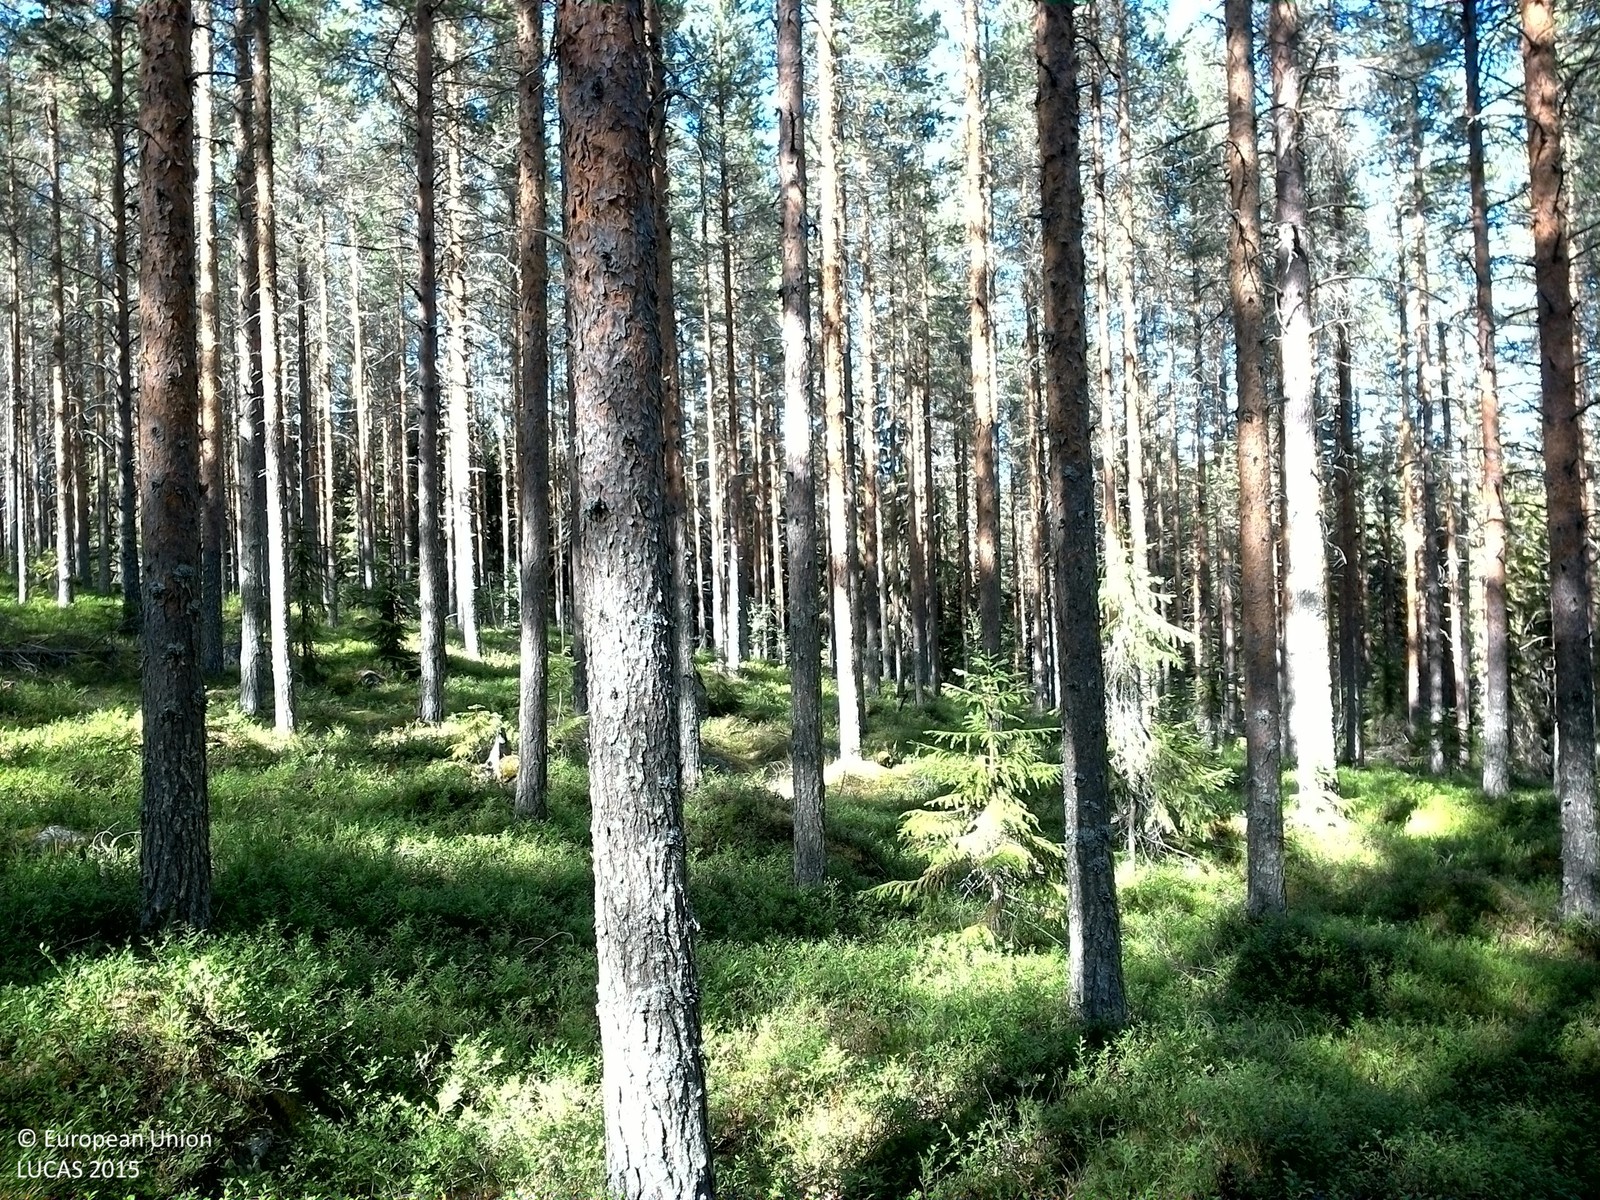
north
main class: Woodland
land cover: Pine dominated coniferous woodland
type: boreal forest
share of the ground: 50 - 75 %
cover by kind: coniferous forest trees 65 %, shrubs 30 %, herbaceous plants 5 %
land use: Forestry
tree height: > 5 m
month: August
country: SE
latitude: 63.5962
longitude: 18.0162
